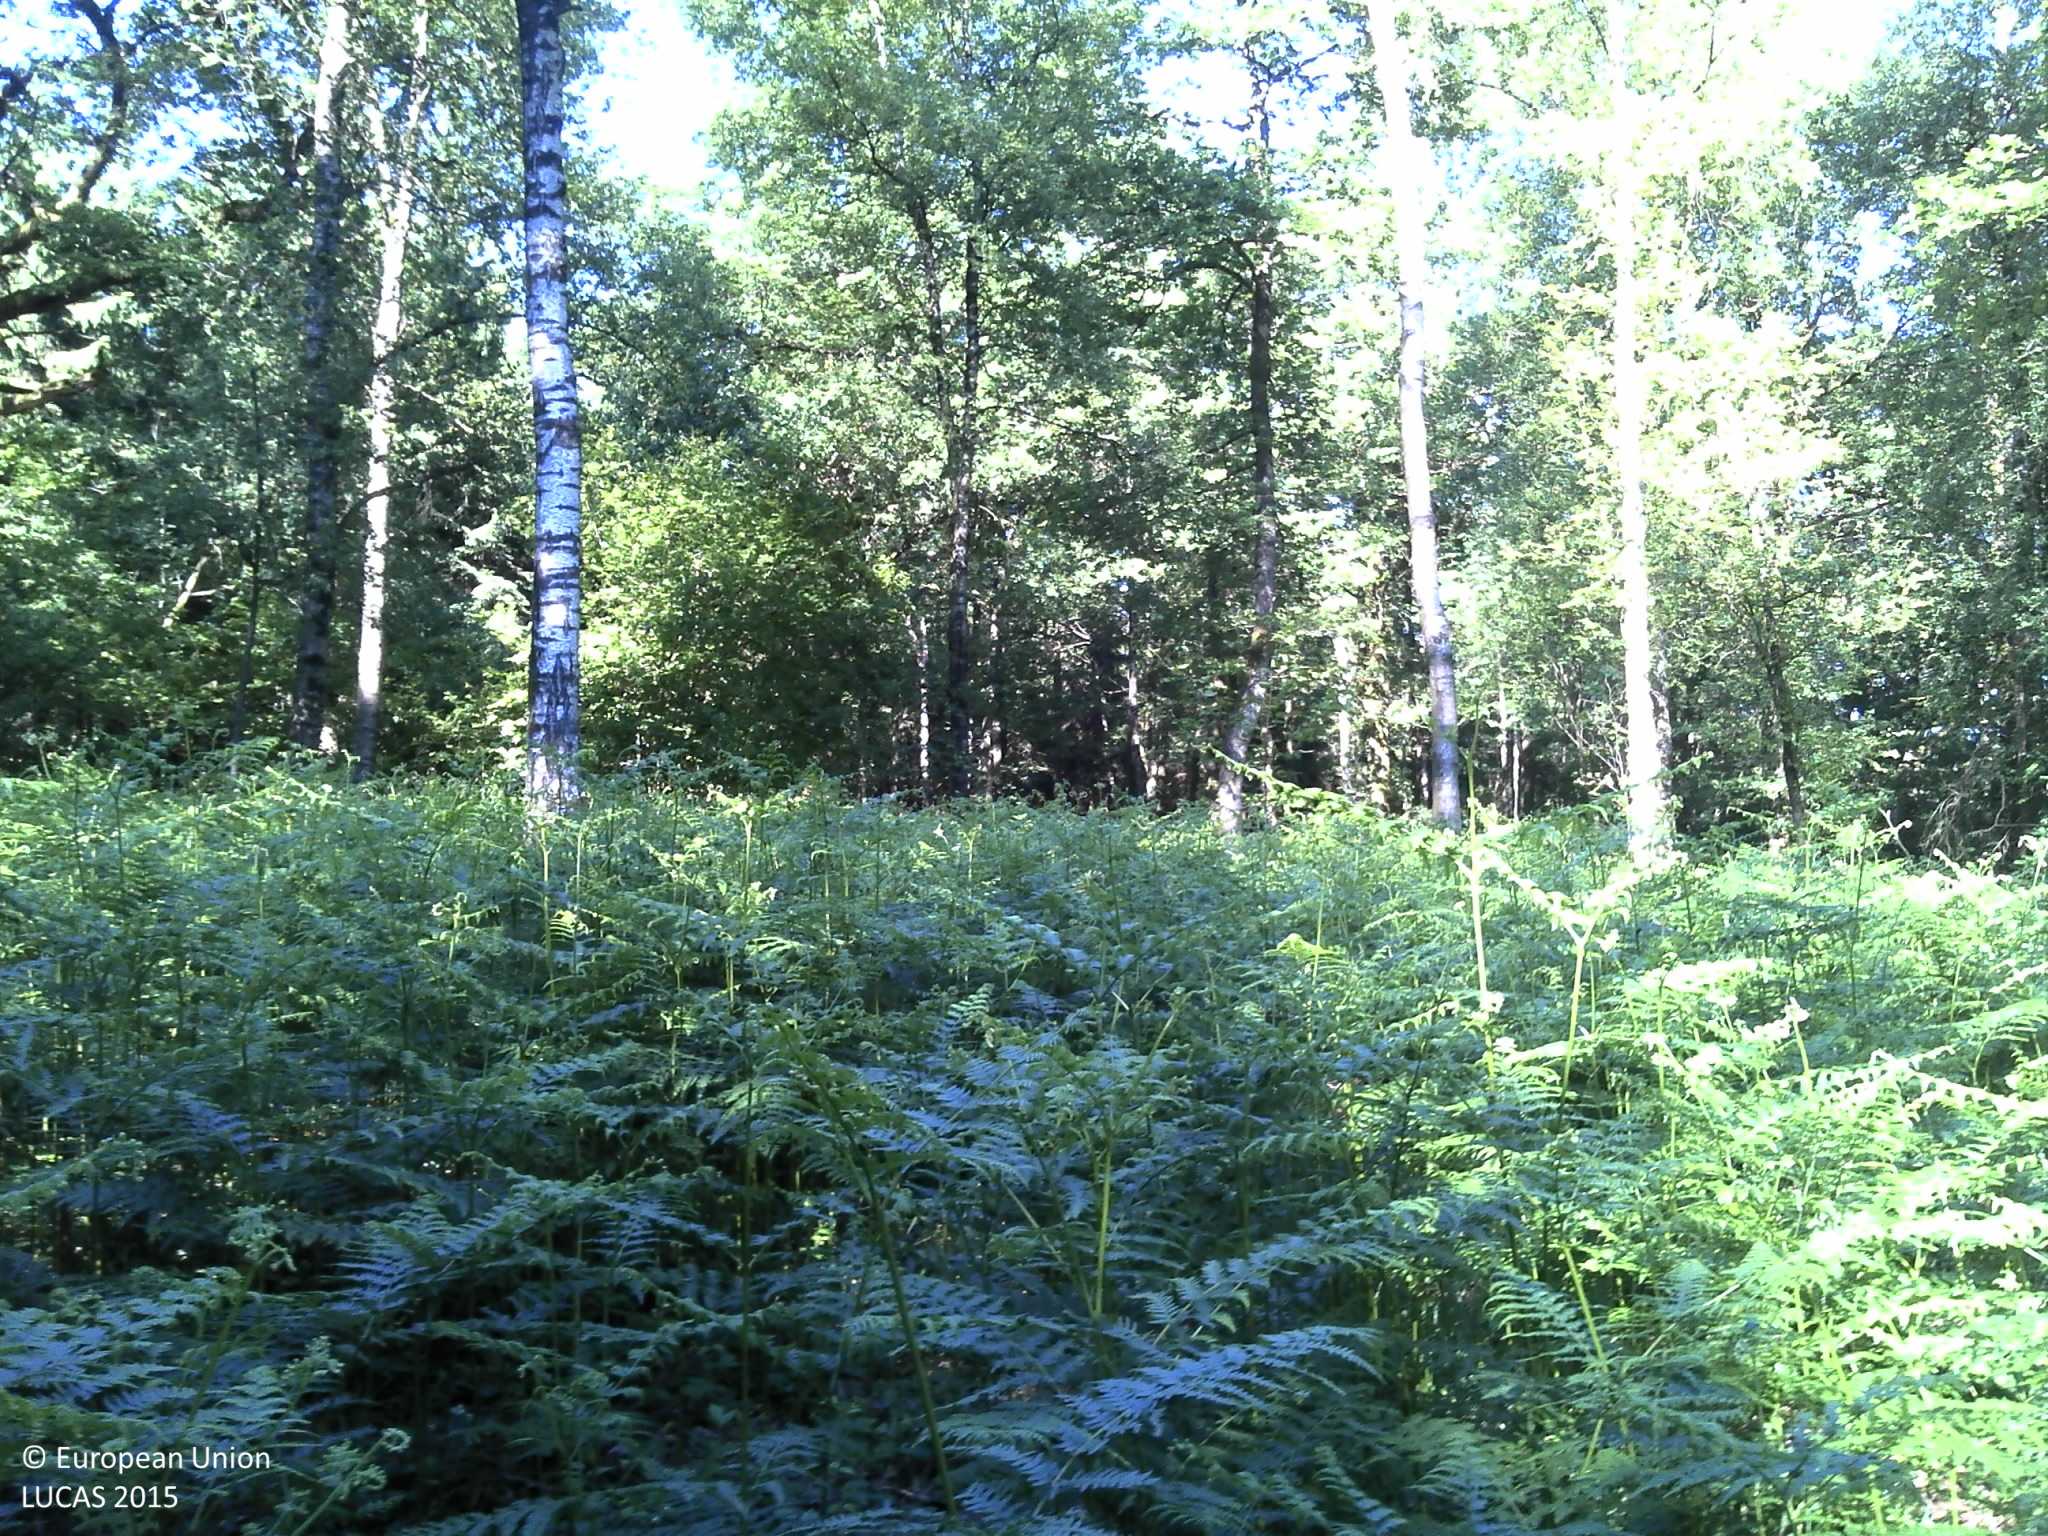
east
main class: Woodland
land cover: Broadleaved woodland
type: acidophilous oak and oak-birch forest
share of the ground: 50 - 75 %
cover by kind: broadleaved forest trees 60 %, herbaceous plants 35 %, lichens and mosses 5 %
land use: Forestry
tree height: > 5 m
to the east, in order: Broadleaved woodland; Ditches and canals; Spruce dominated coniferous woodland; Spontaneously vegetated surfaces; Spruce dominated coniferous woodland; Ditches and canals; Tracks; Grass margins; Spruce dominated coniferous woodland
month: June
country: FR
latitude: 49.9549
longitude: 4.7420
